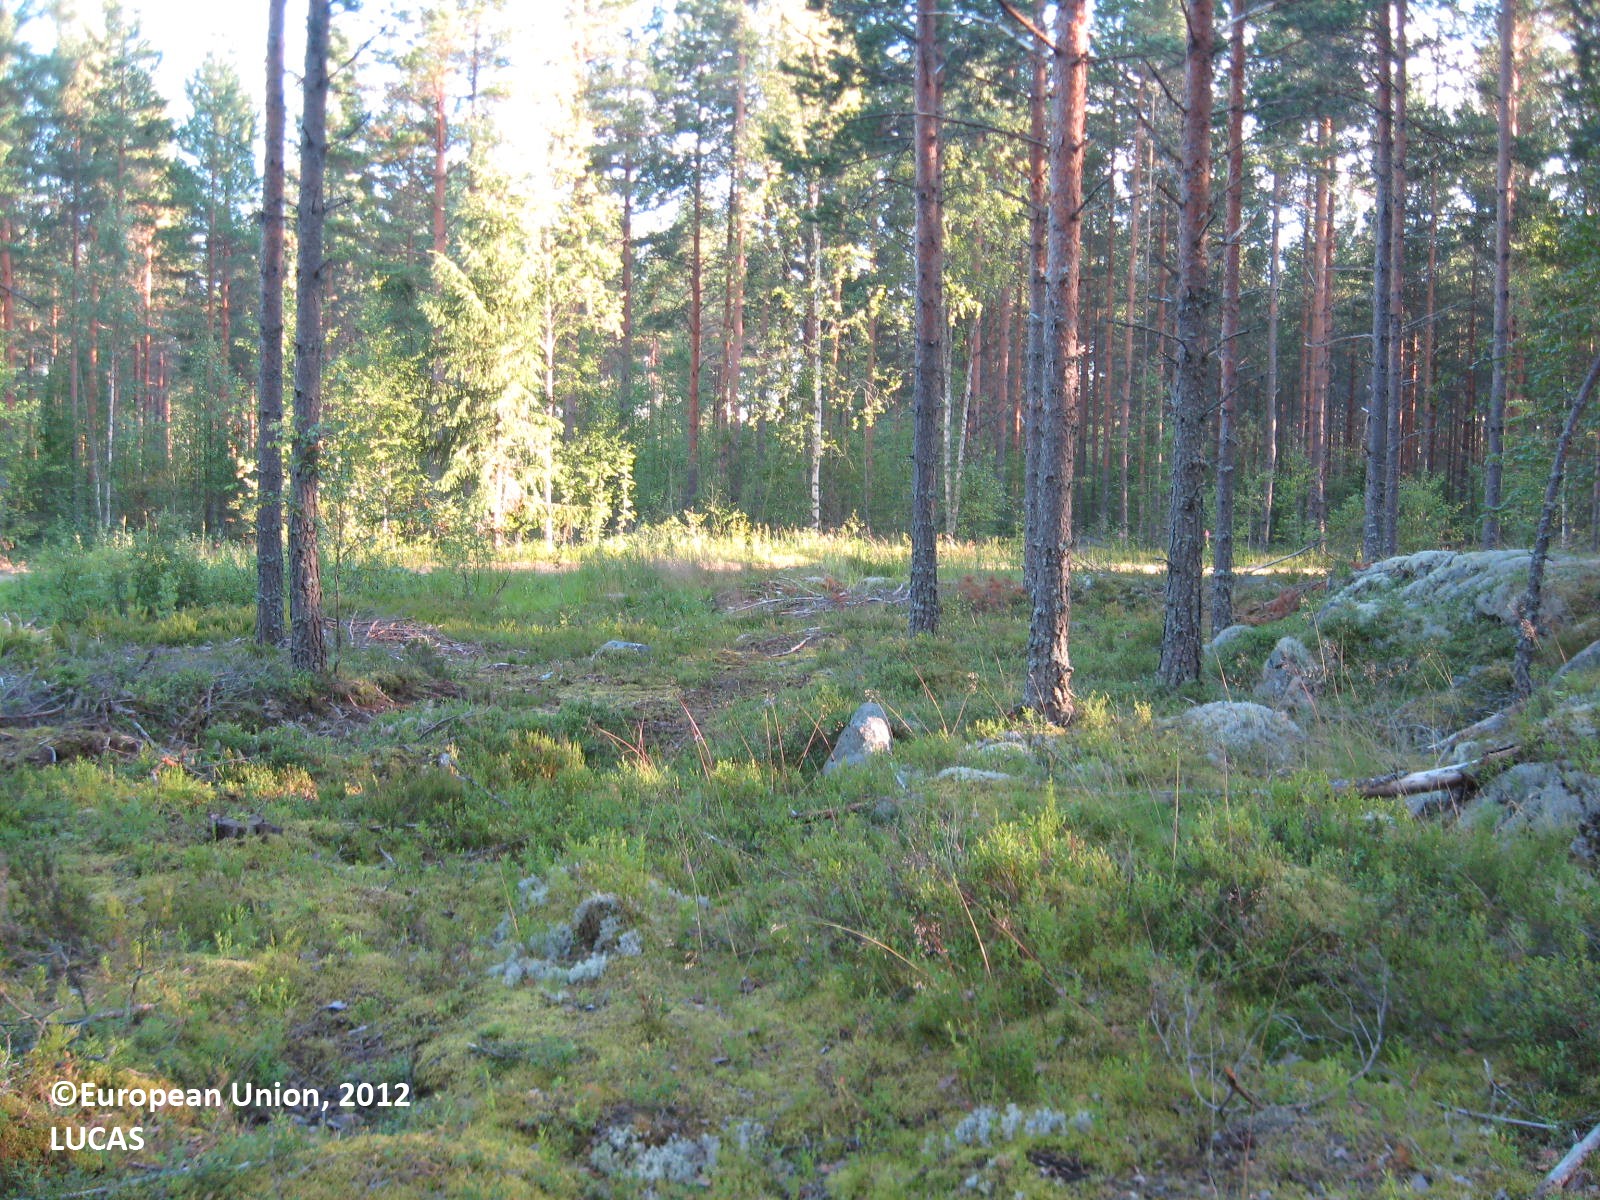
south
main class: Woodland
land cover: Pine dominated coniferous woodland
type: boreal forest
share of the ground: > 75 %
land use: Forestry
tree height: > 5 m
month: July
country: FI
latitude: 61.9435
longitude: 22.2735
